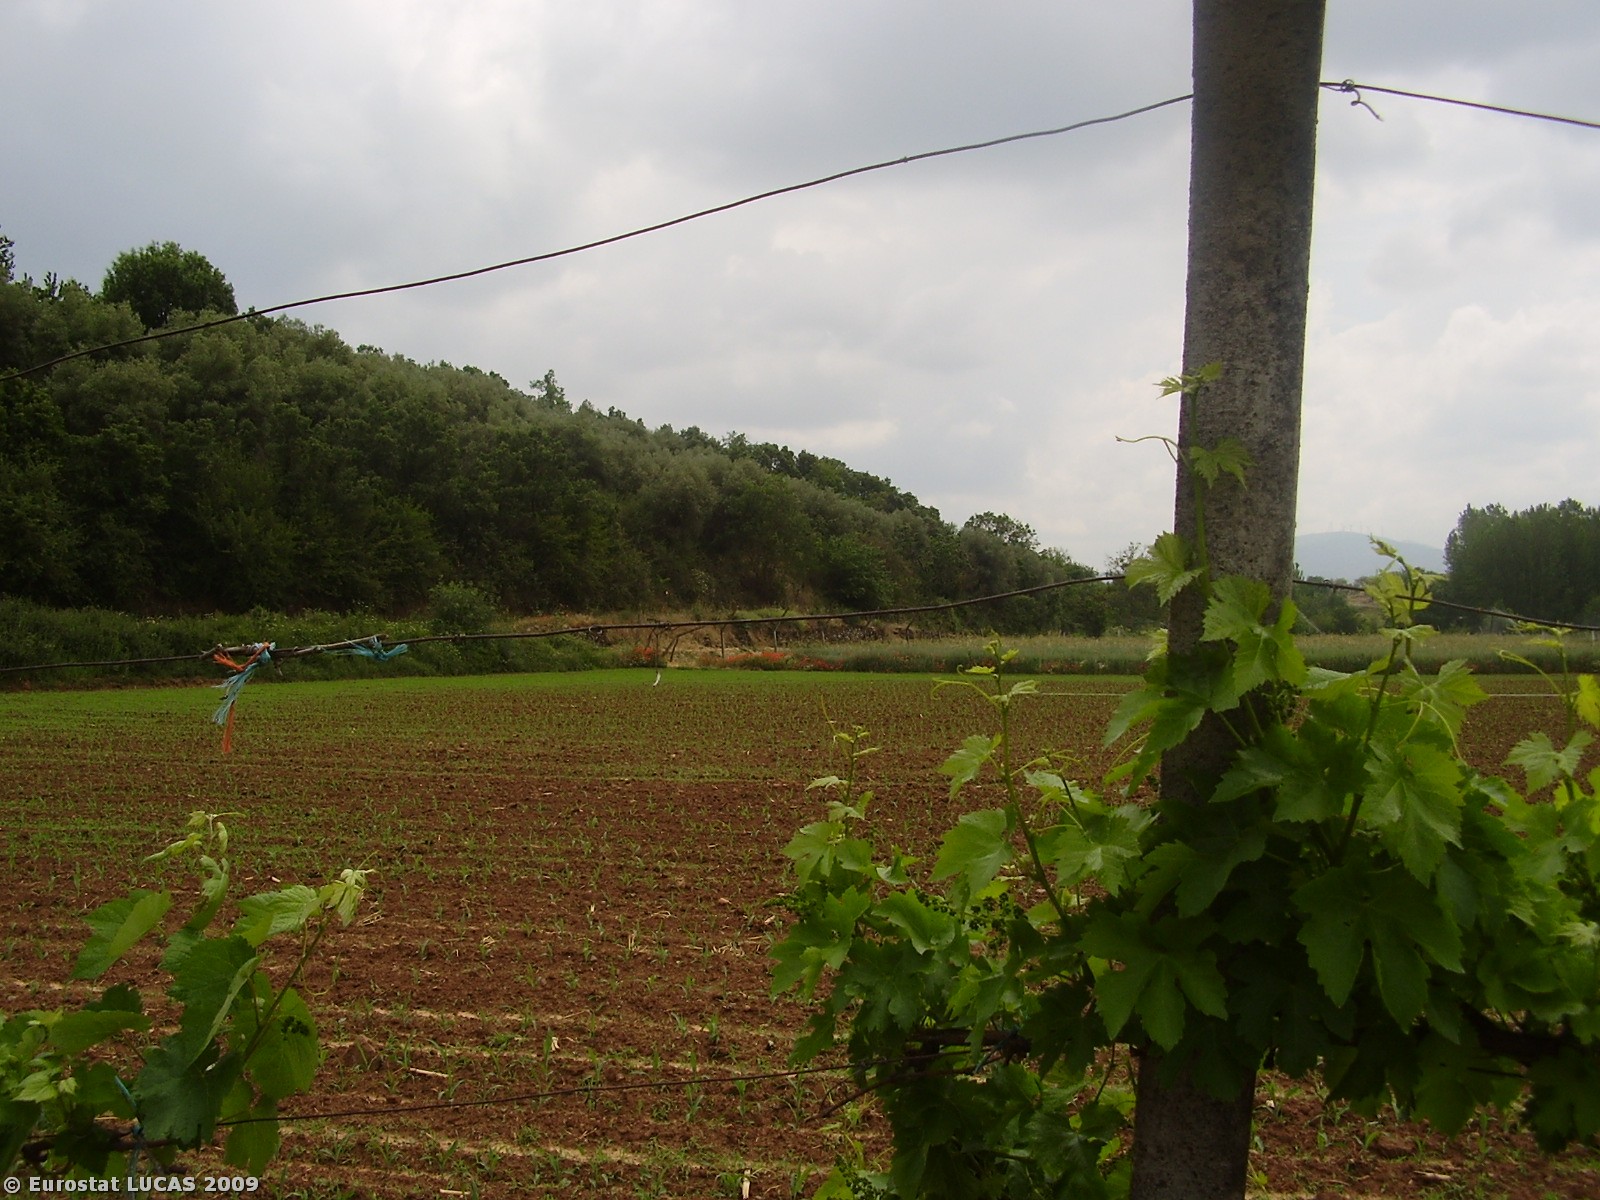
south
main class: Cropland
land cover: Mixed cereals for fodder
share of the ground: > 75 %
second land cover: Pear fruit
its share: < 10 %
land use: Agriculture (excluding fallow land and kitchen gardens)
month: June
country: PT
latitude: 41.5596
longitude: -6.8628
